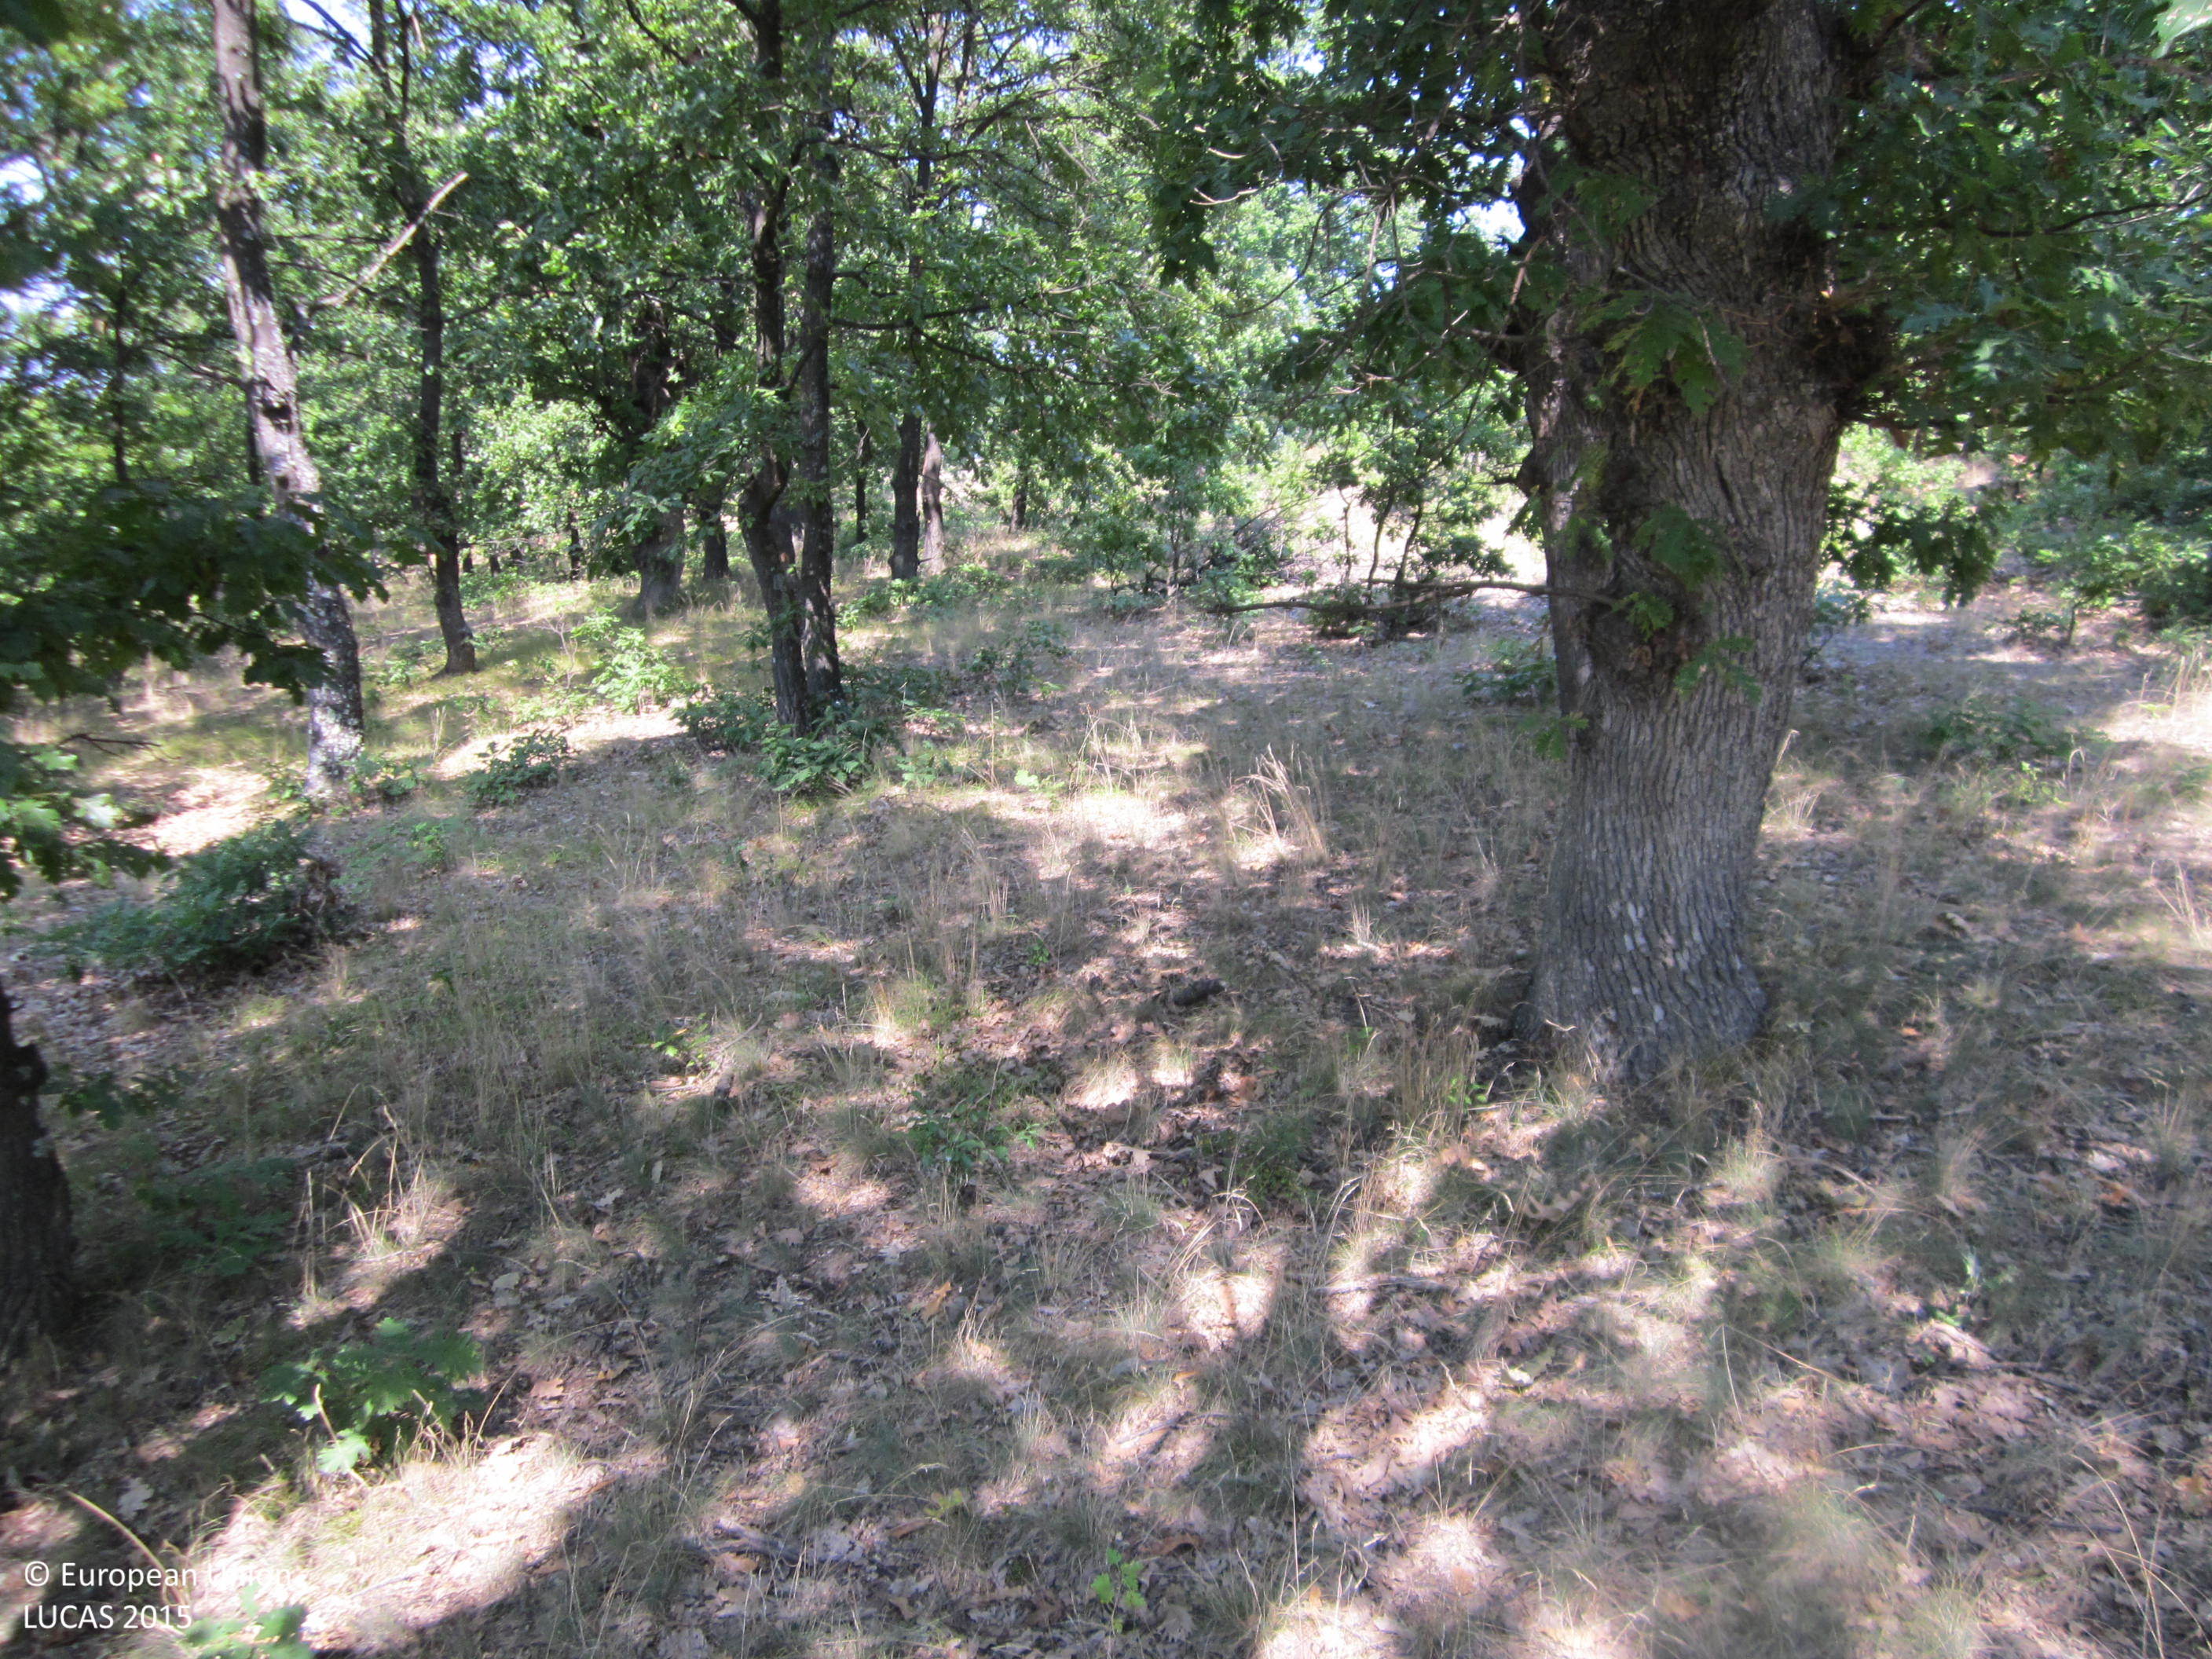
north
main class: Woodland
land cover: Broadleaved woodland
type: thermophilous deciduous forest
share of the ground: > 75 %
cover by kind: broadleaved forest trees 75 %, herbaceous plants 20 %, unconsolidated bare surface 5 %
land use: Forestry
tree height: > 5 m
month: September
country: BG
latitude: 42.8556
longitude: 27.0355
